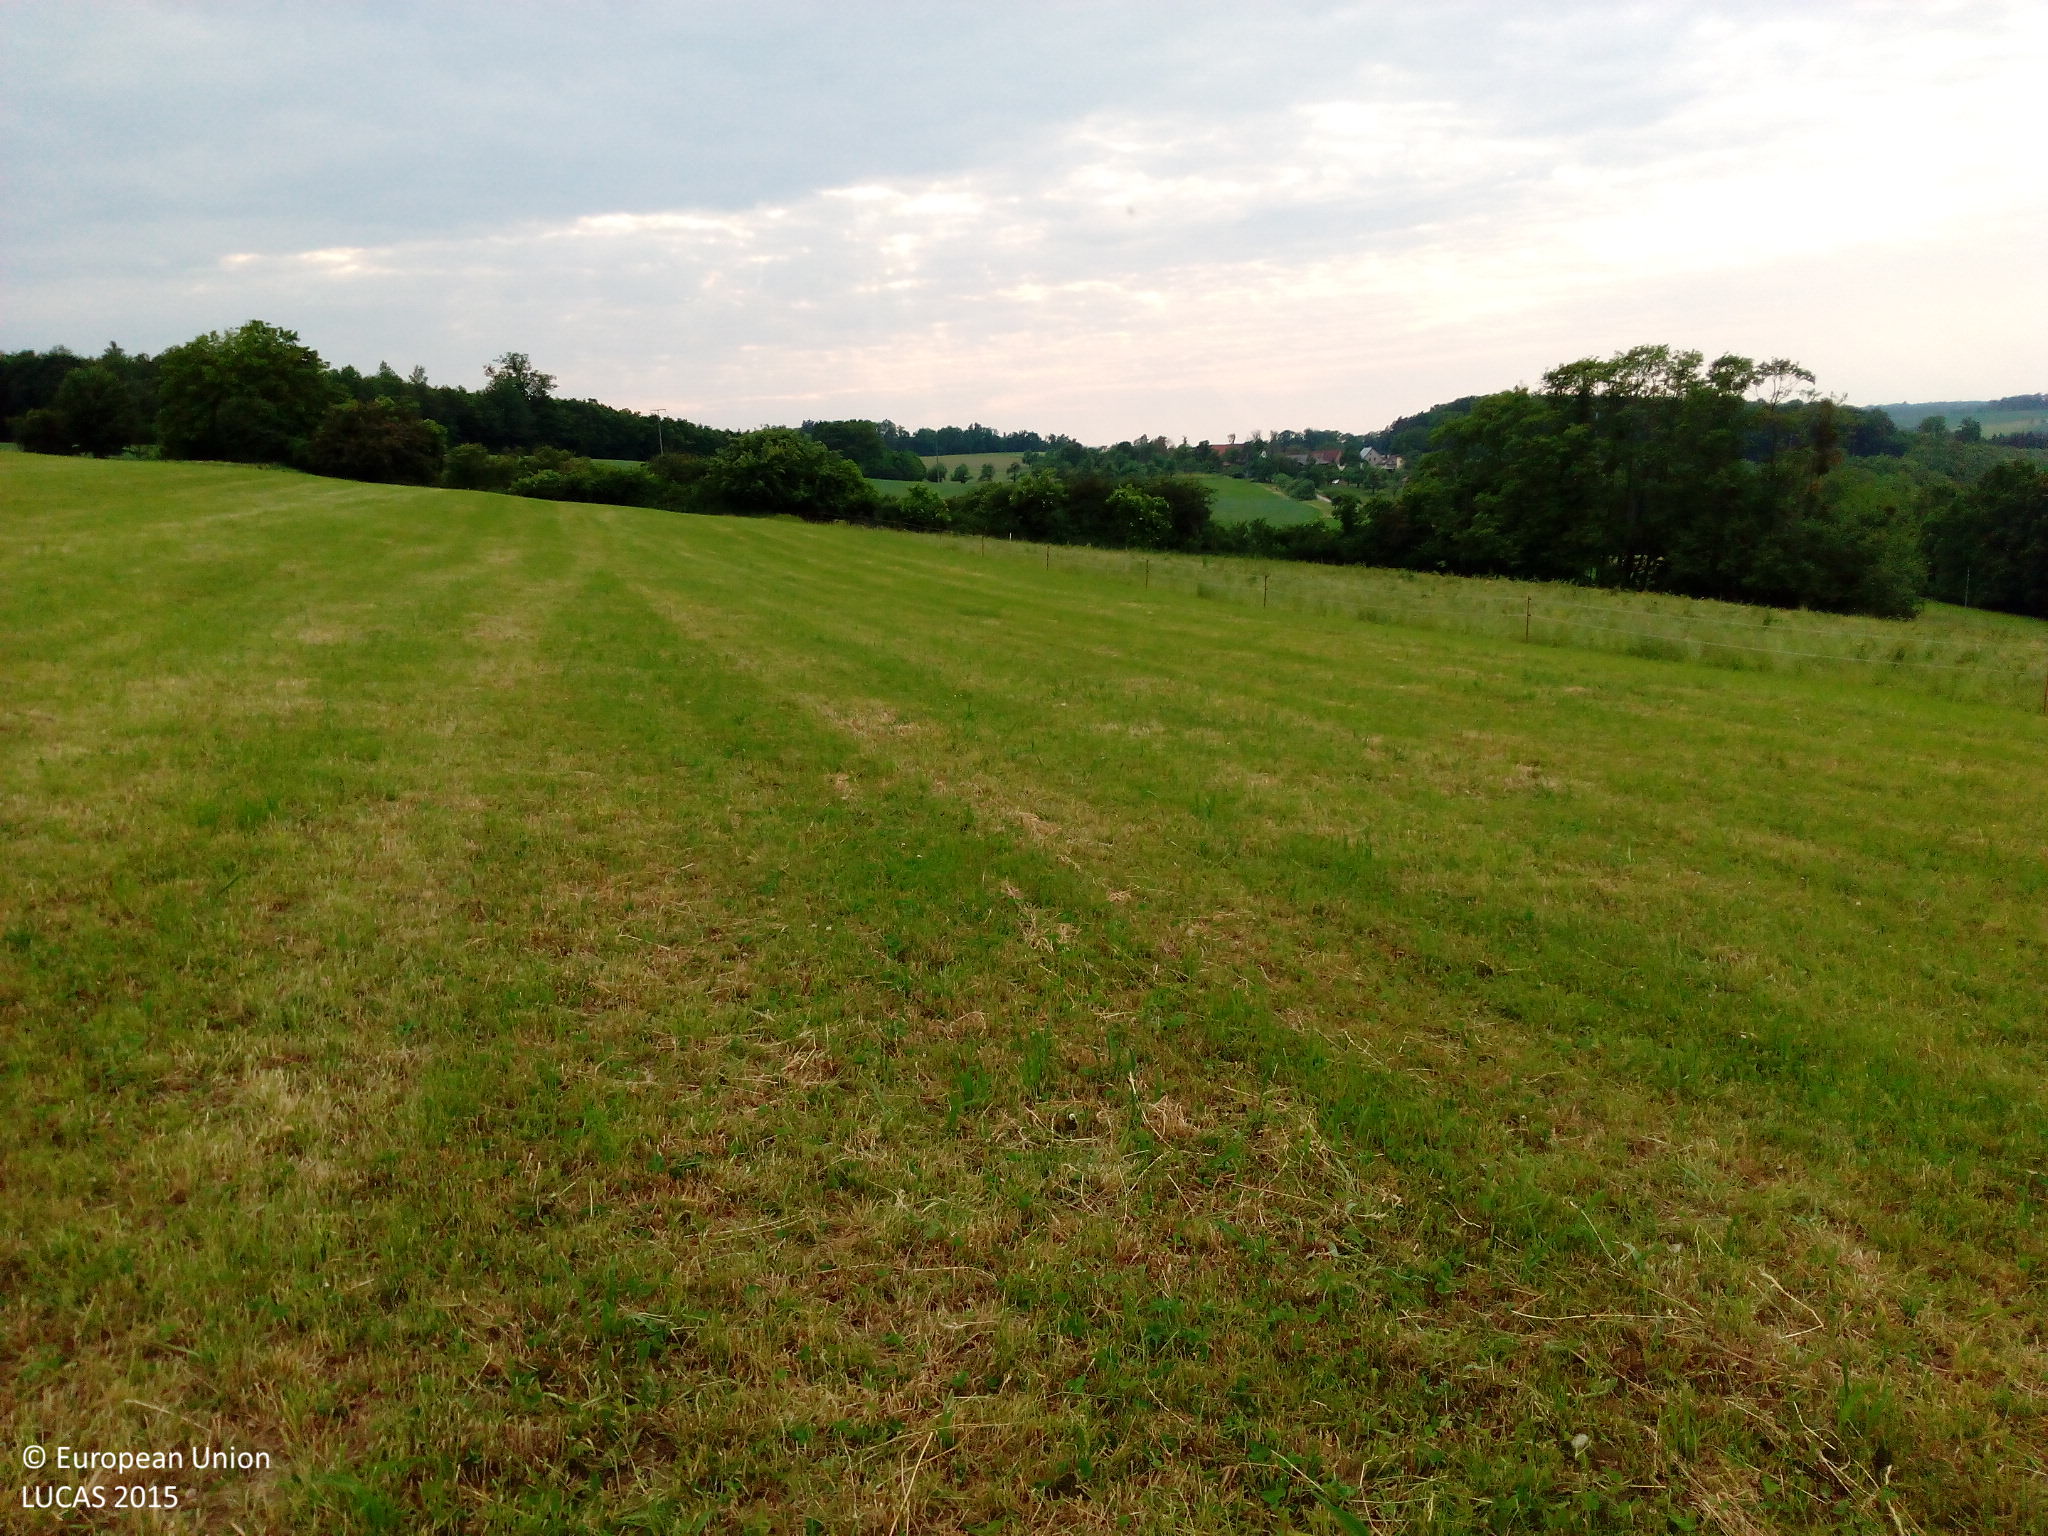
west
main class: Grassland
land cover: Grassland without tree/shrub cover
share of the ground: > 75 %
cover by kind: herbaceous plants 100 %
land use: Agriculture (excluding fallow land and kitchen gardens)
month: May
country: DE
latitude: 49.2843
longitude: 9.6015
